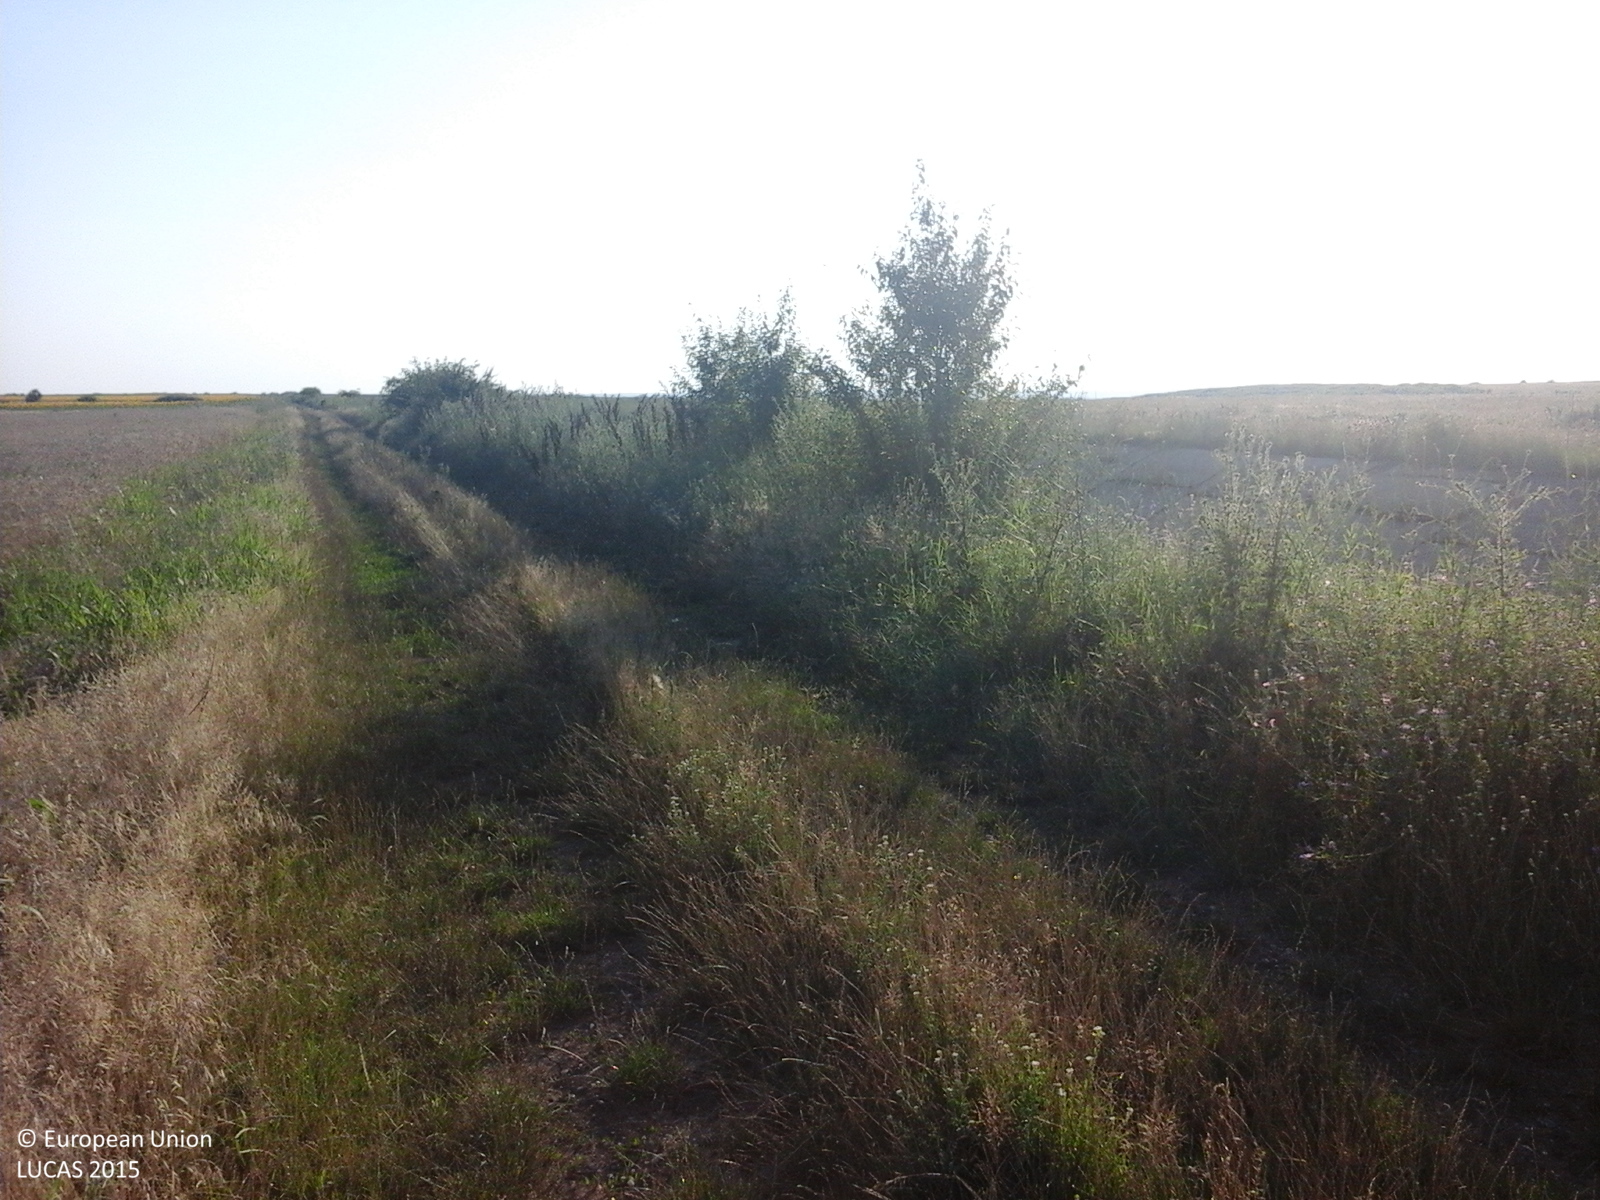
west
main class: Cropland
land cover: Common wheat
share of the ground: > 75 %
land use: Agriculture (excluding fallow land and kitchen gardens)
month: July
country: RO
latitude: 44.2857
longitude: 24.4413
